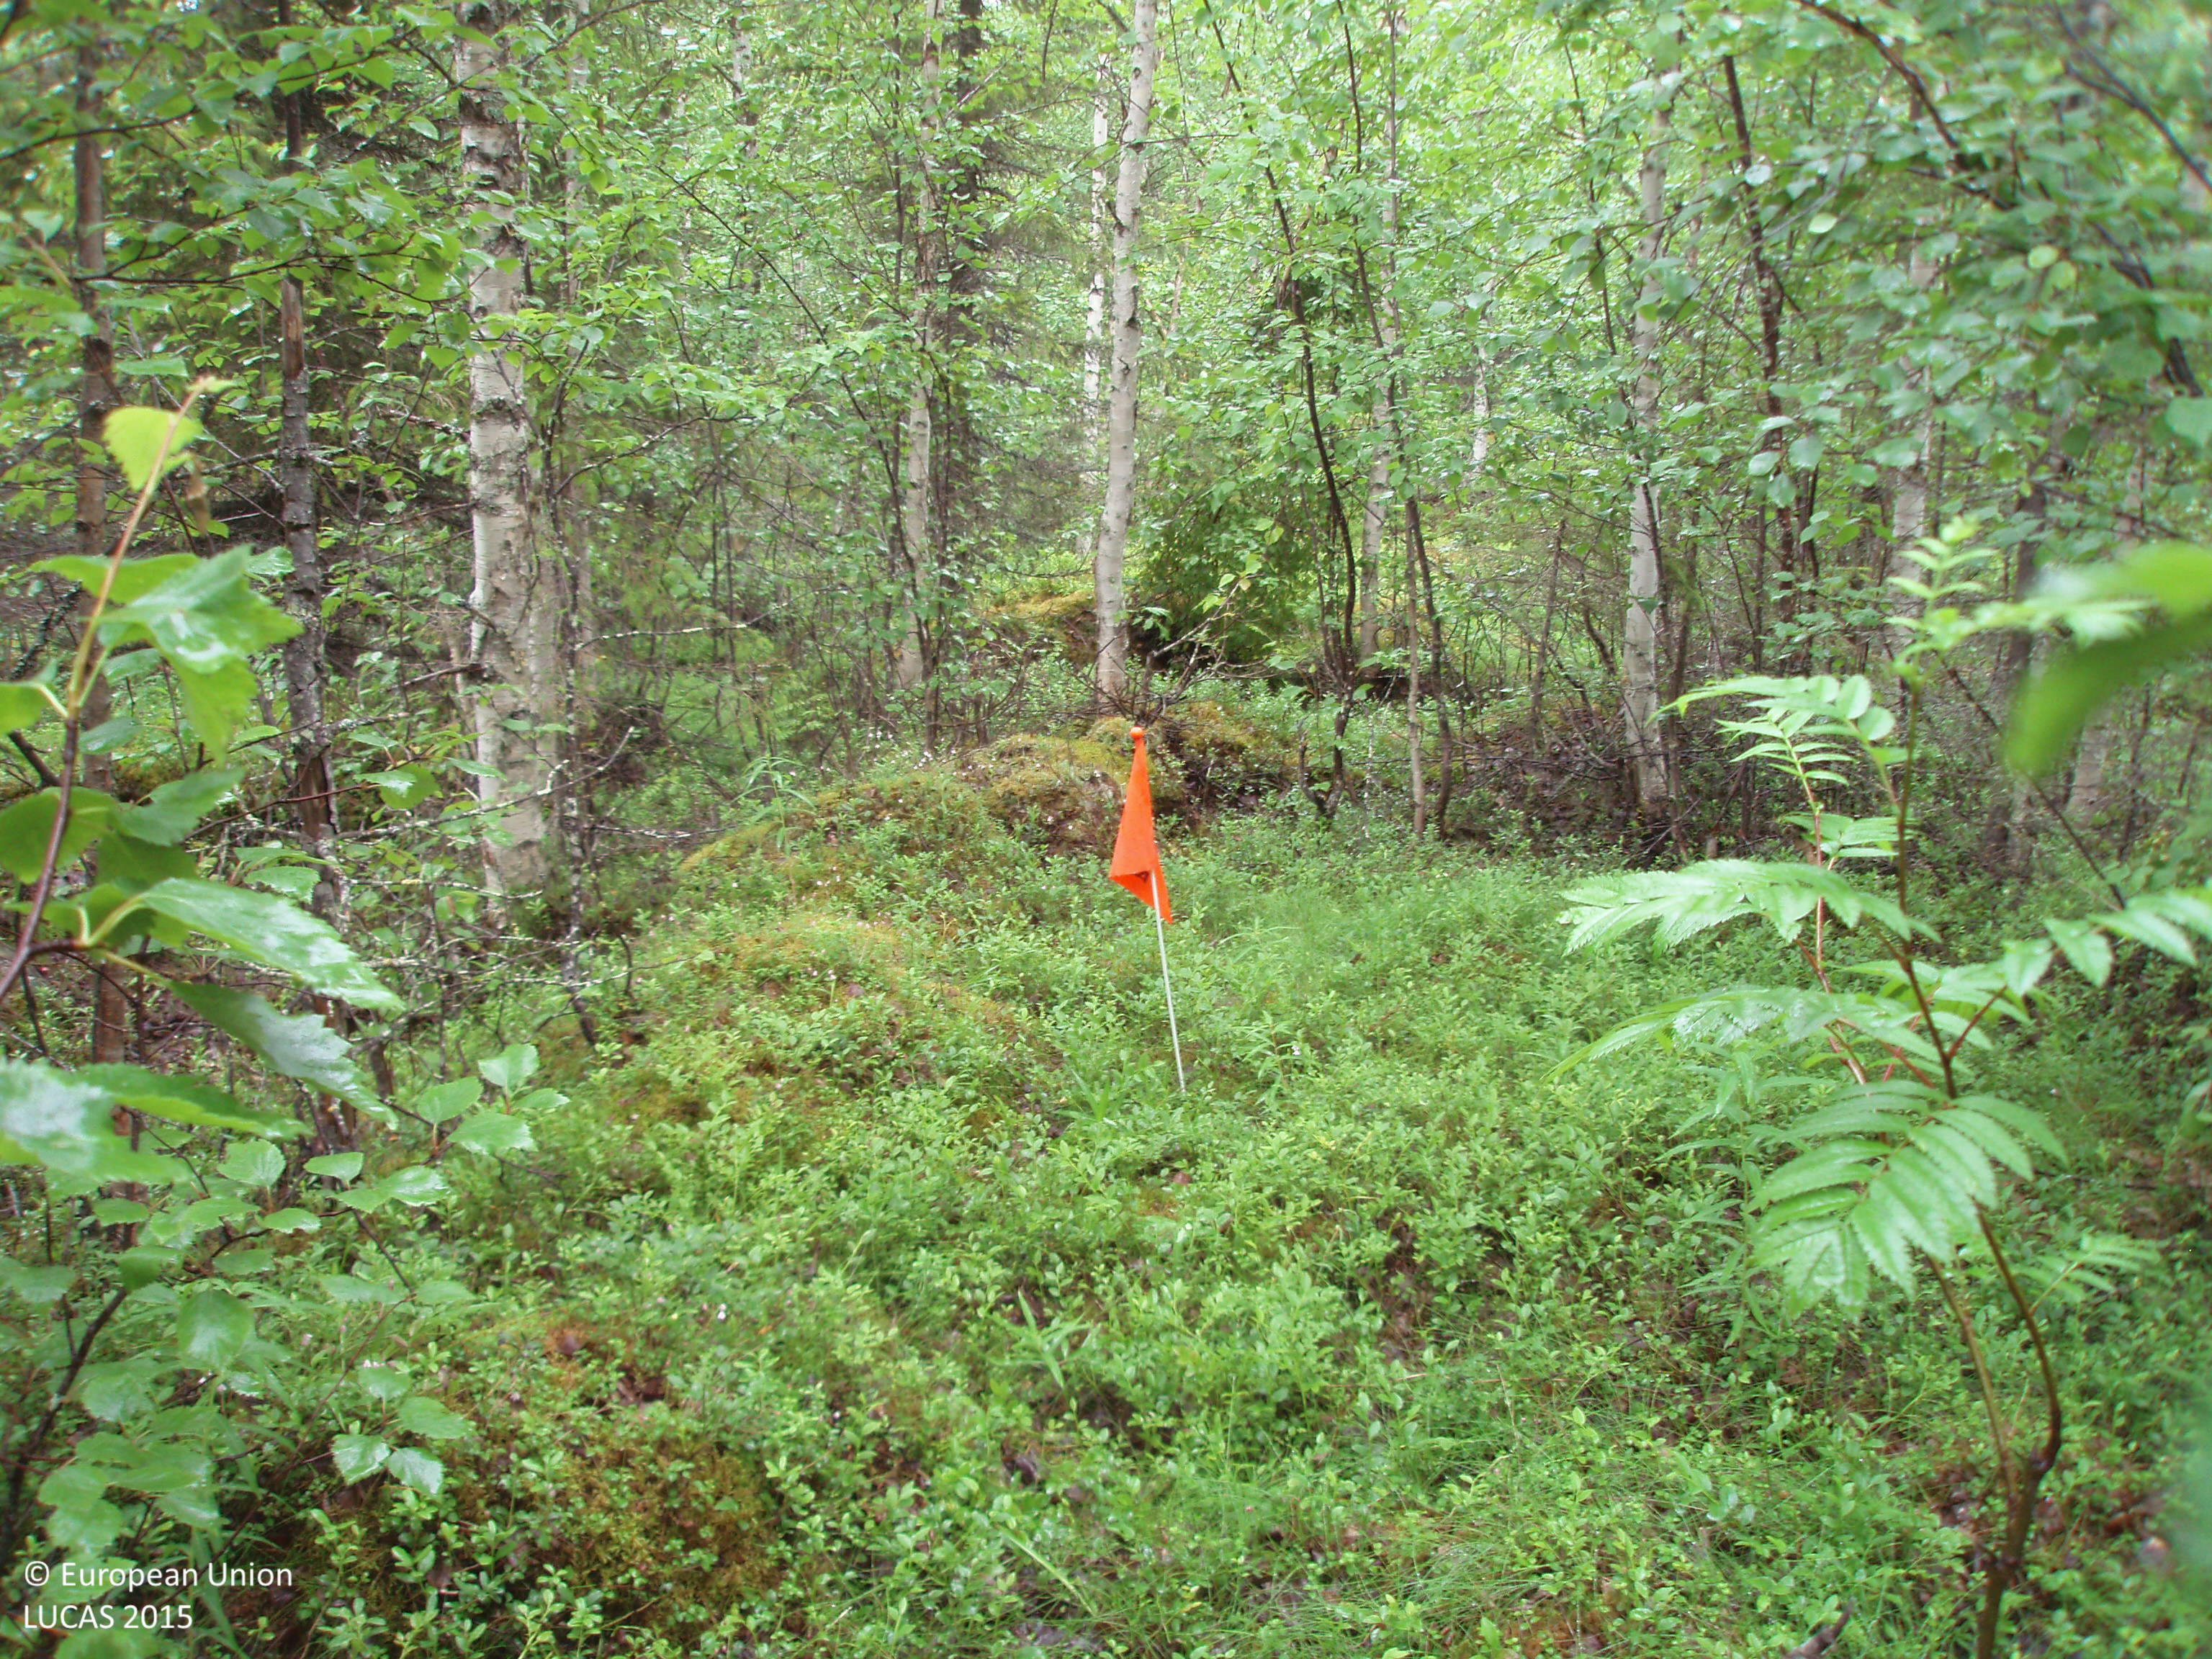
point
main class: Woodland
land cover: Broadleaved woodland
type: boreal forest
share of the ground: > 75 %
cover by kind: broadleaved forest trees 85 %, shrubs 10 %, coniferous forest trees 5 %
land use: Forestry
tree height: > 5 m
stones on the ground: < 10 %
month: July
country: FI
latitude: 66.7039
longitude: 28.2854
